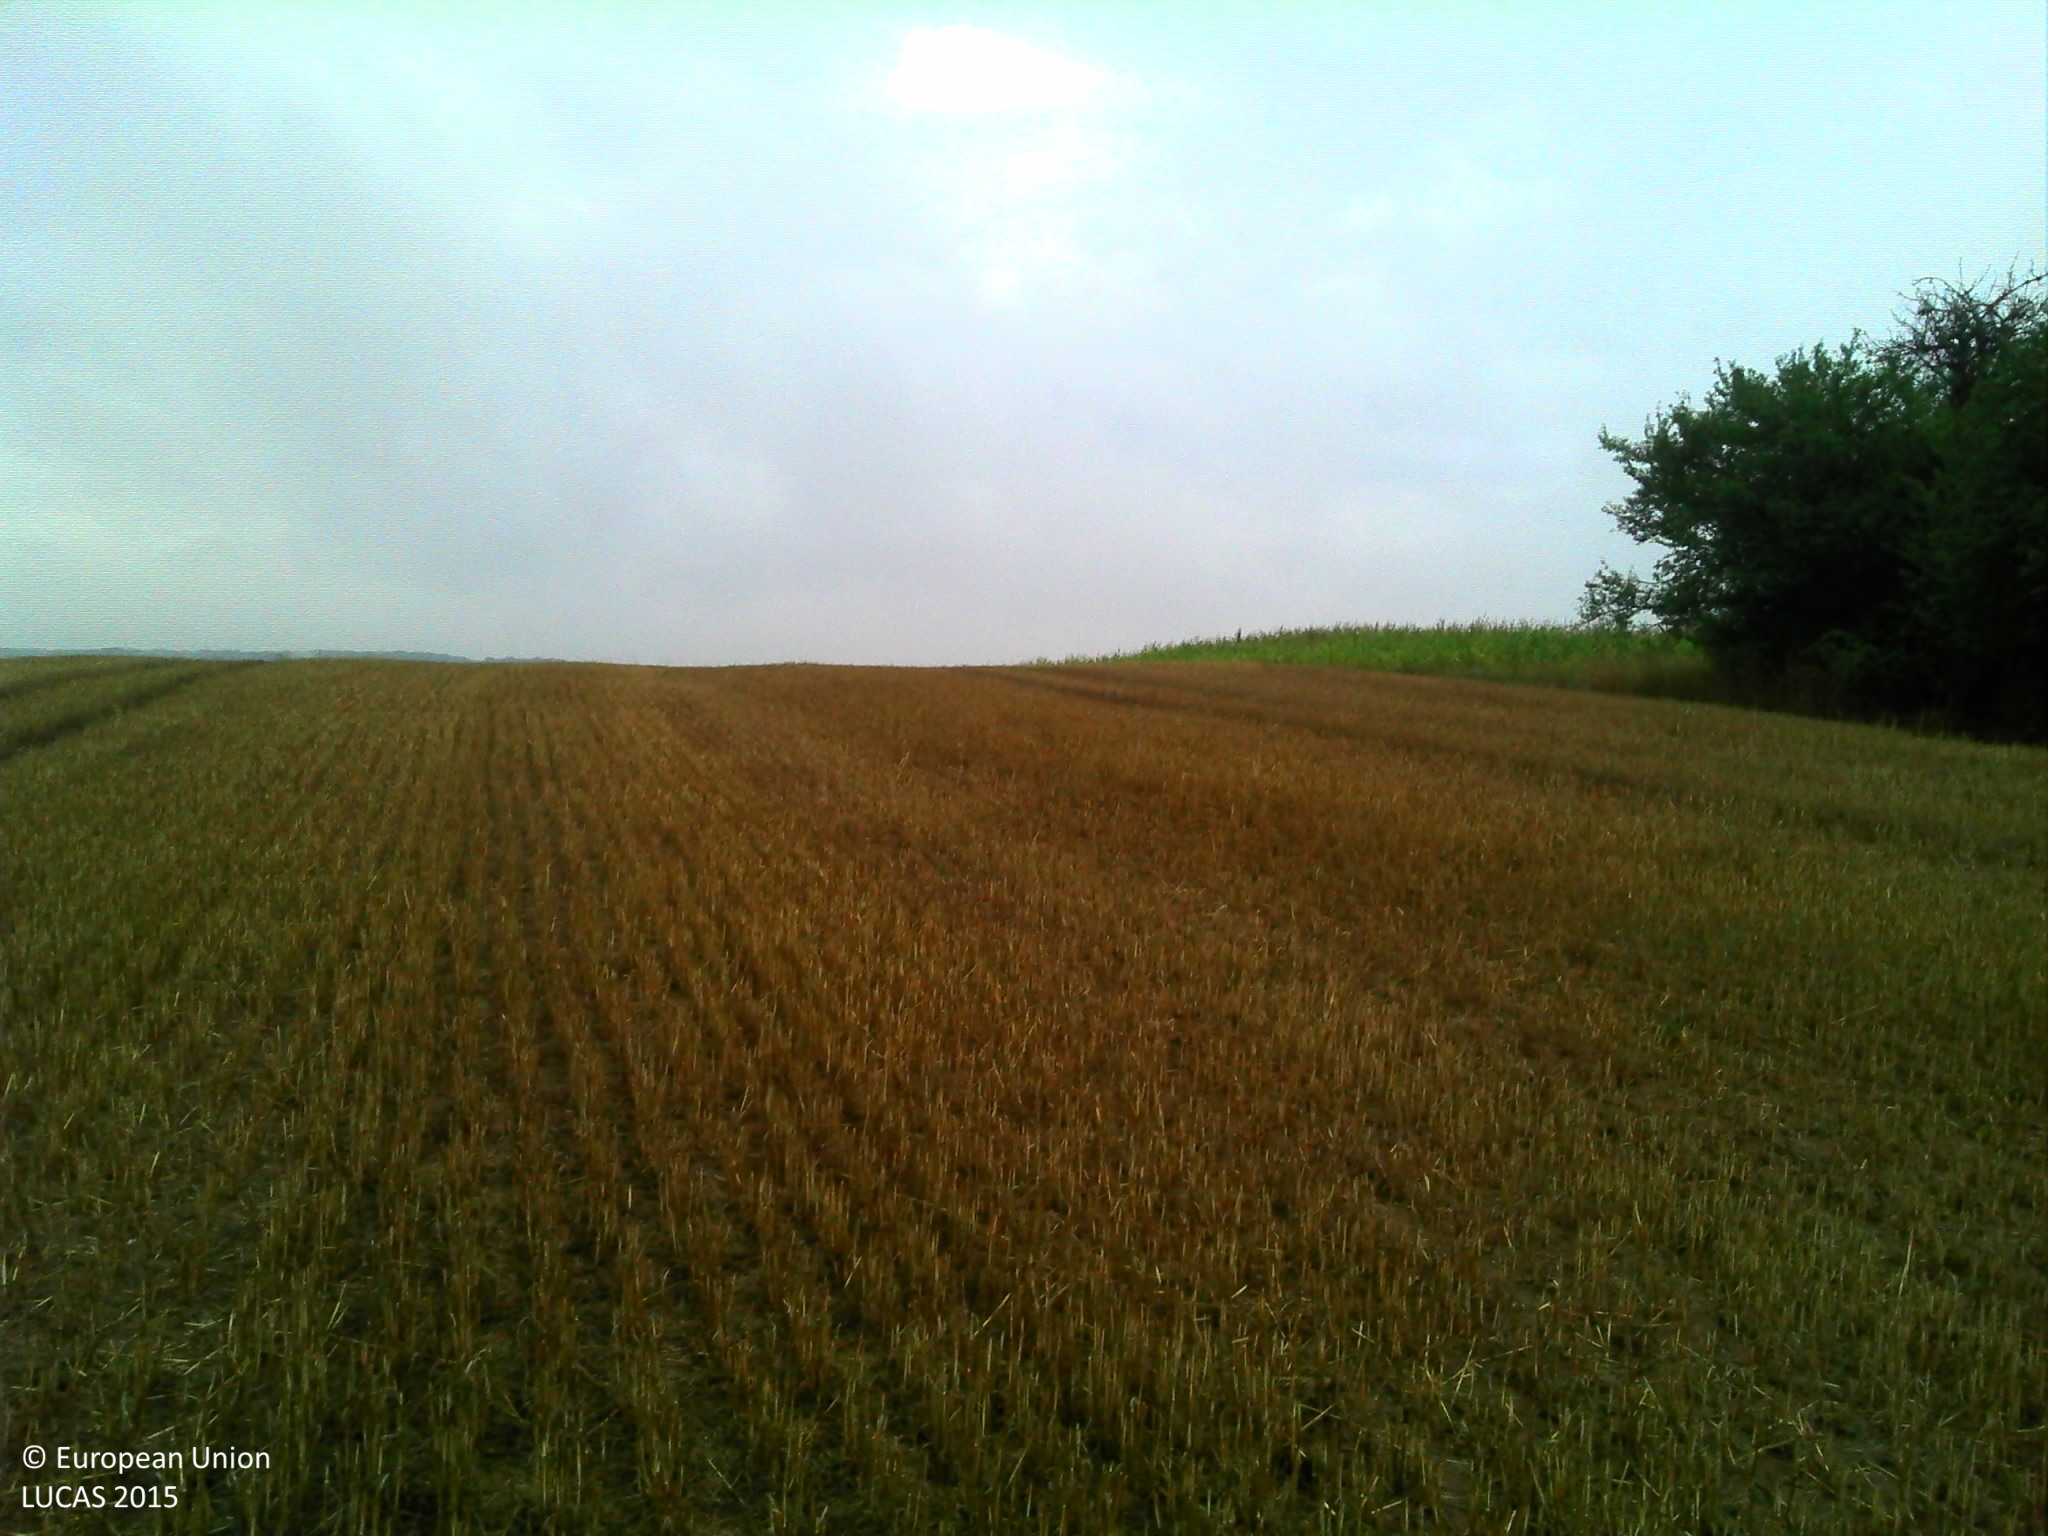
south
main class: Cropland
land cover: Triticale
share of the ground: 50 - 75 %
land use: Agriculture (excluding fallow land and kitchen gardens)
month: August
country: FR
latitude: 48.8608
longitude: 7.4790
